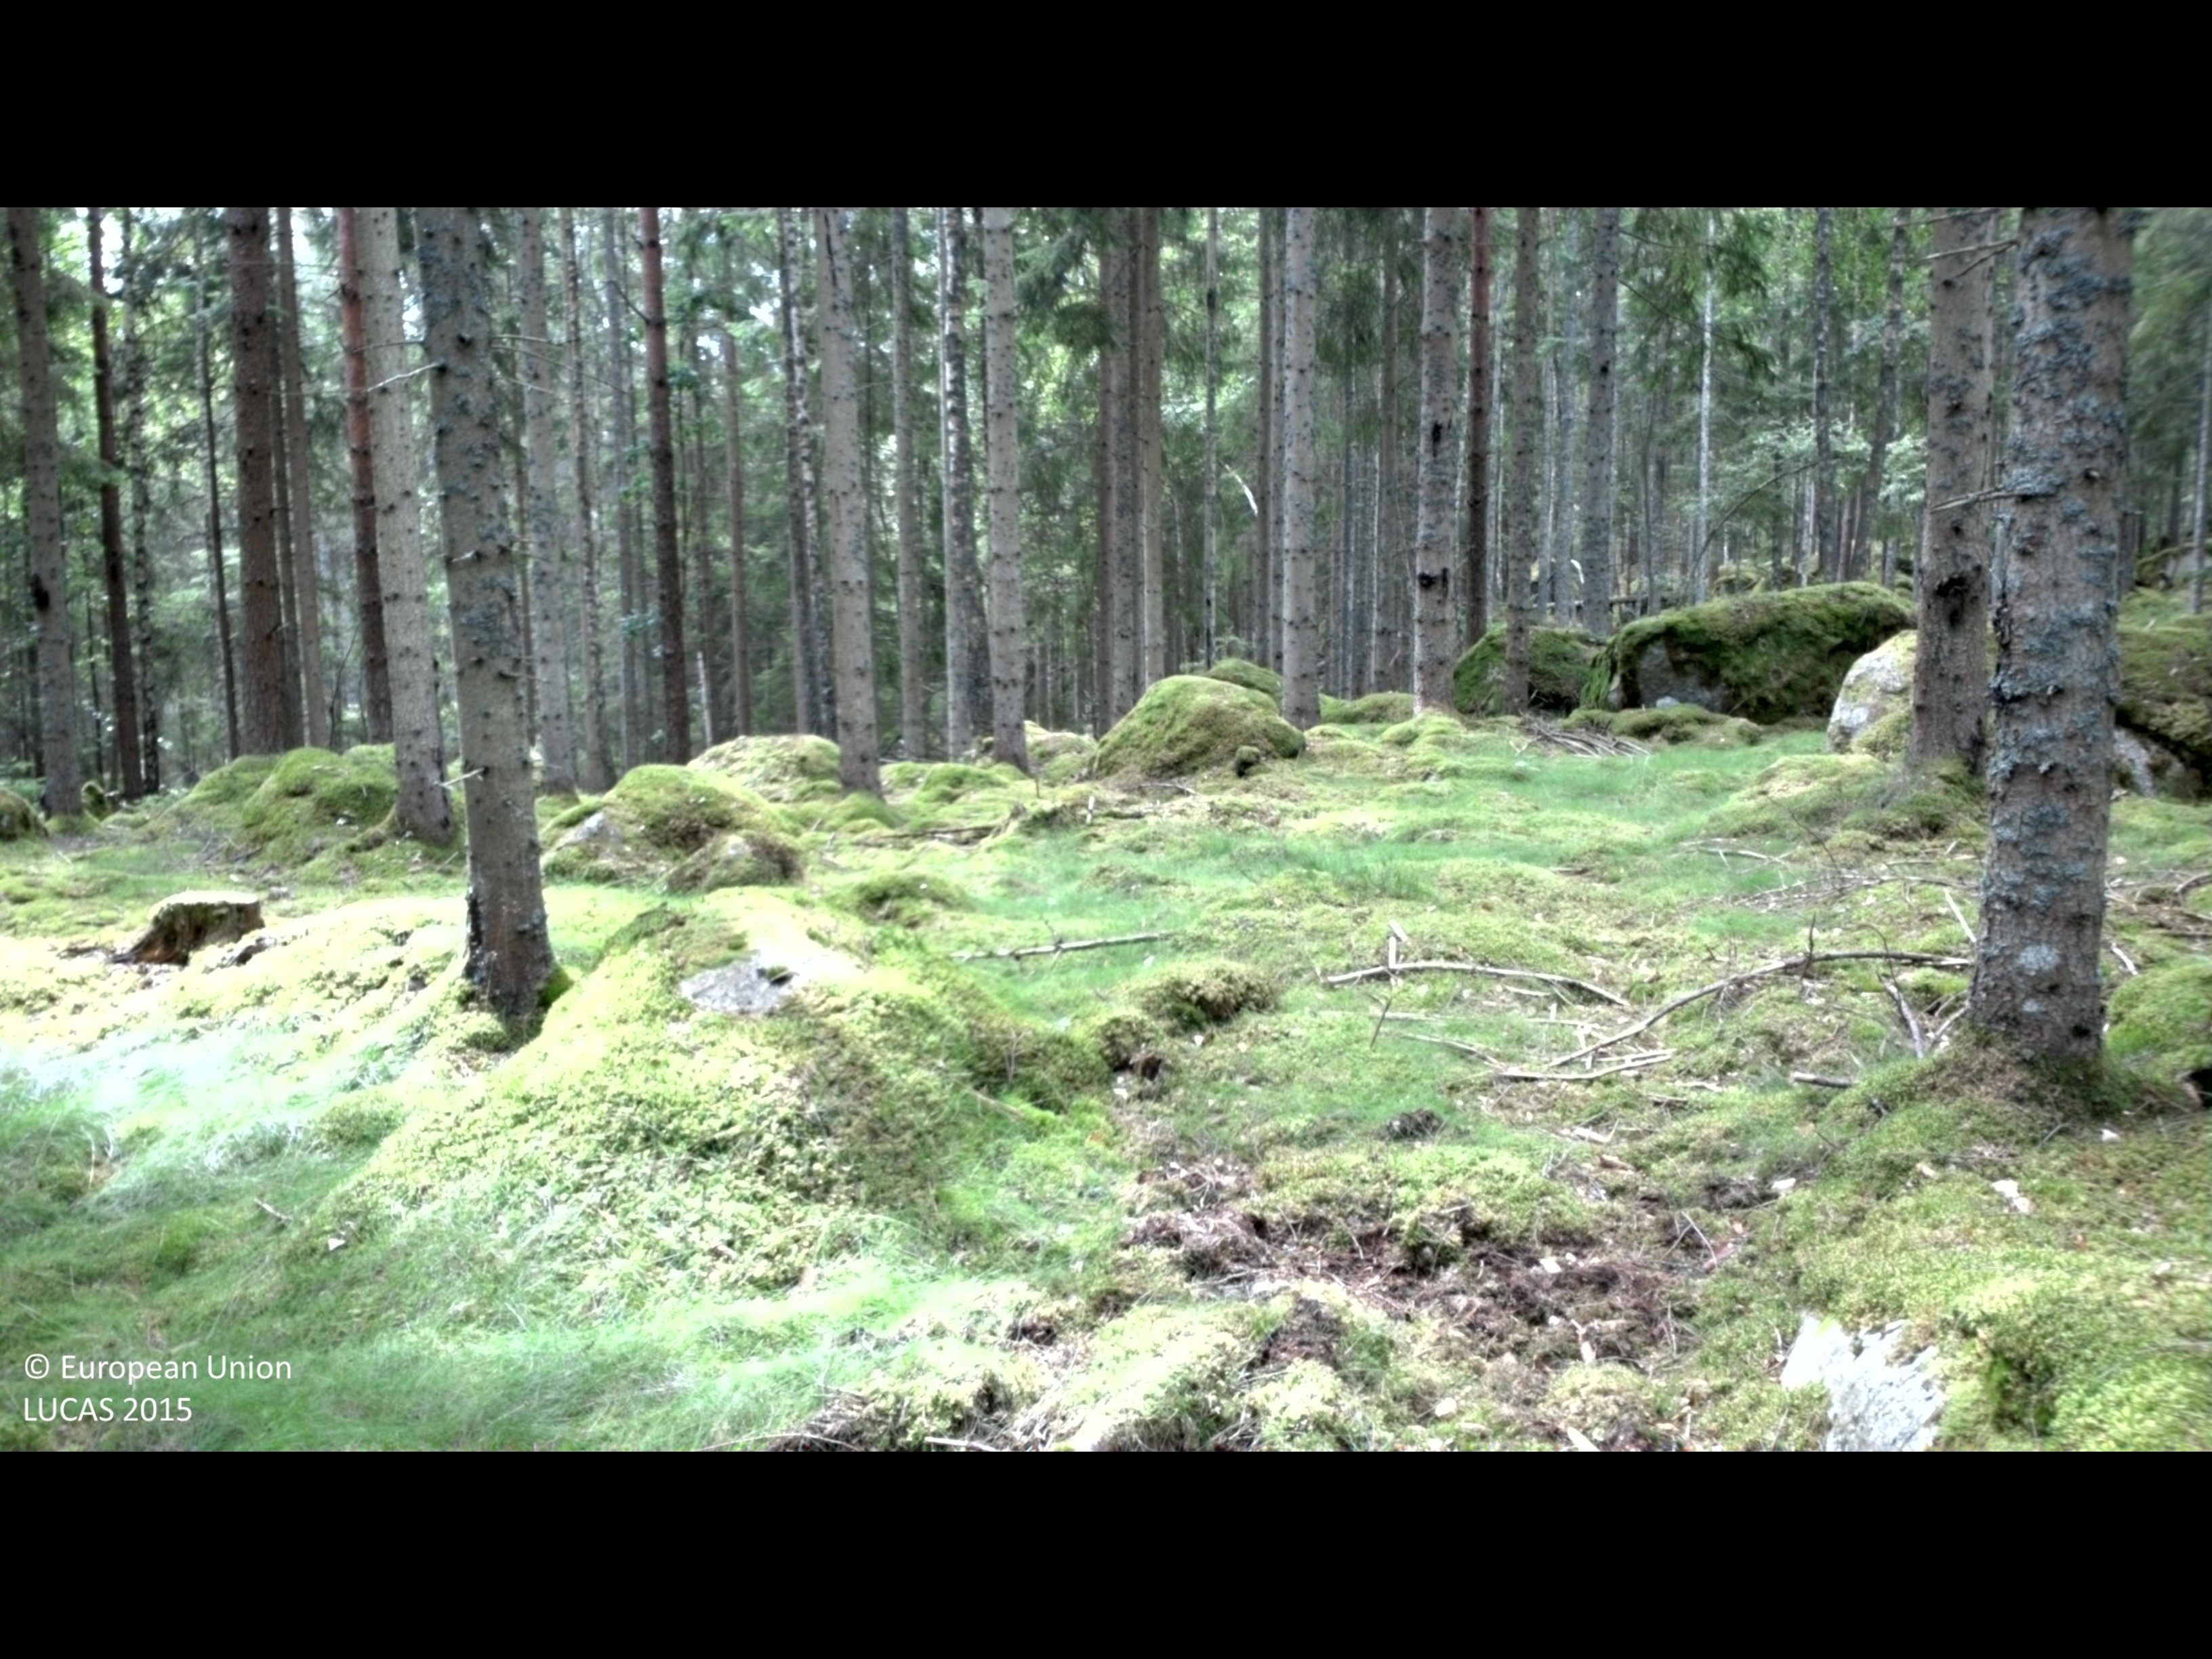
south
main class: Woodland
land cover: Spruce dominated coniferous woodland
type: boreal forest
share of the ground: > 75 %
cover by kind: coniferous forest trees 75 %, lichens and mosses 25 %
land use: Forestry
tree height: > 5 m
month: August
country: SE
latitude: 56.4312
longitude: 14.5543
